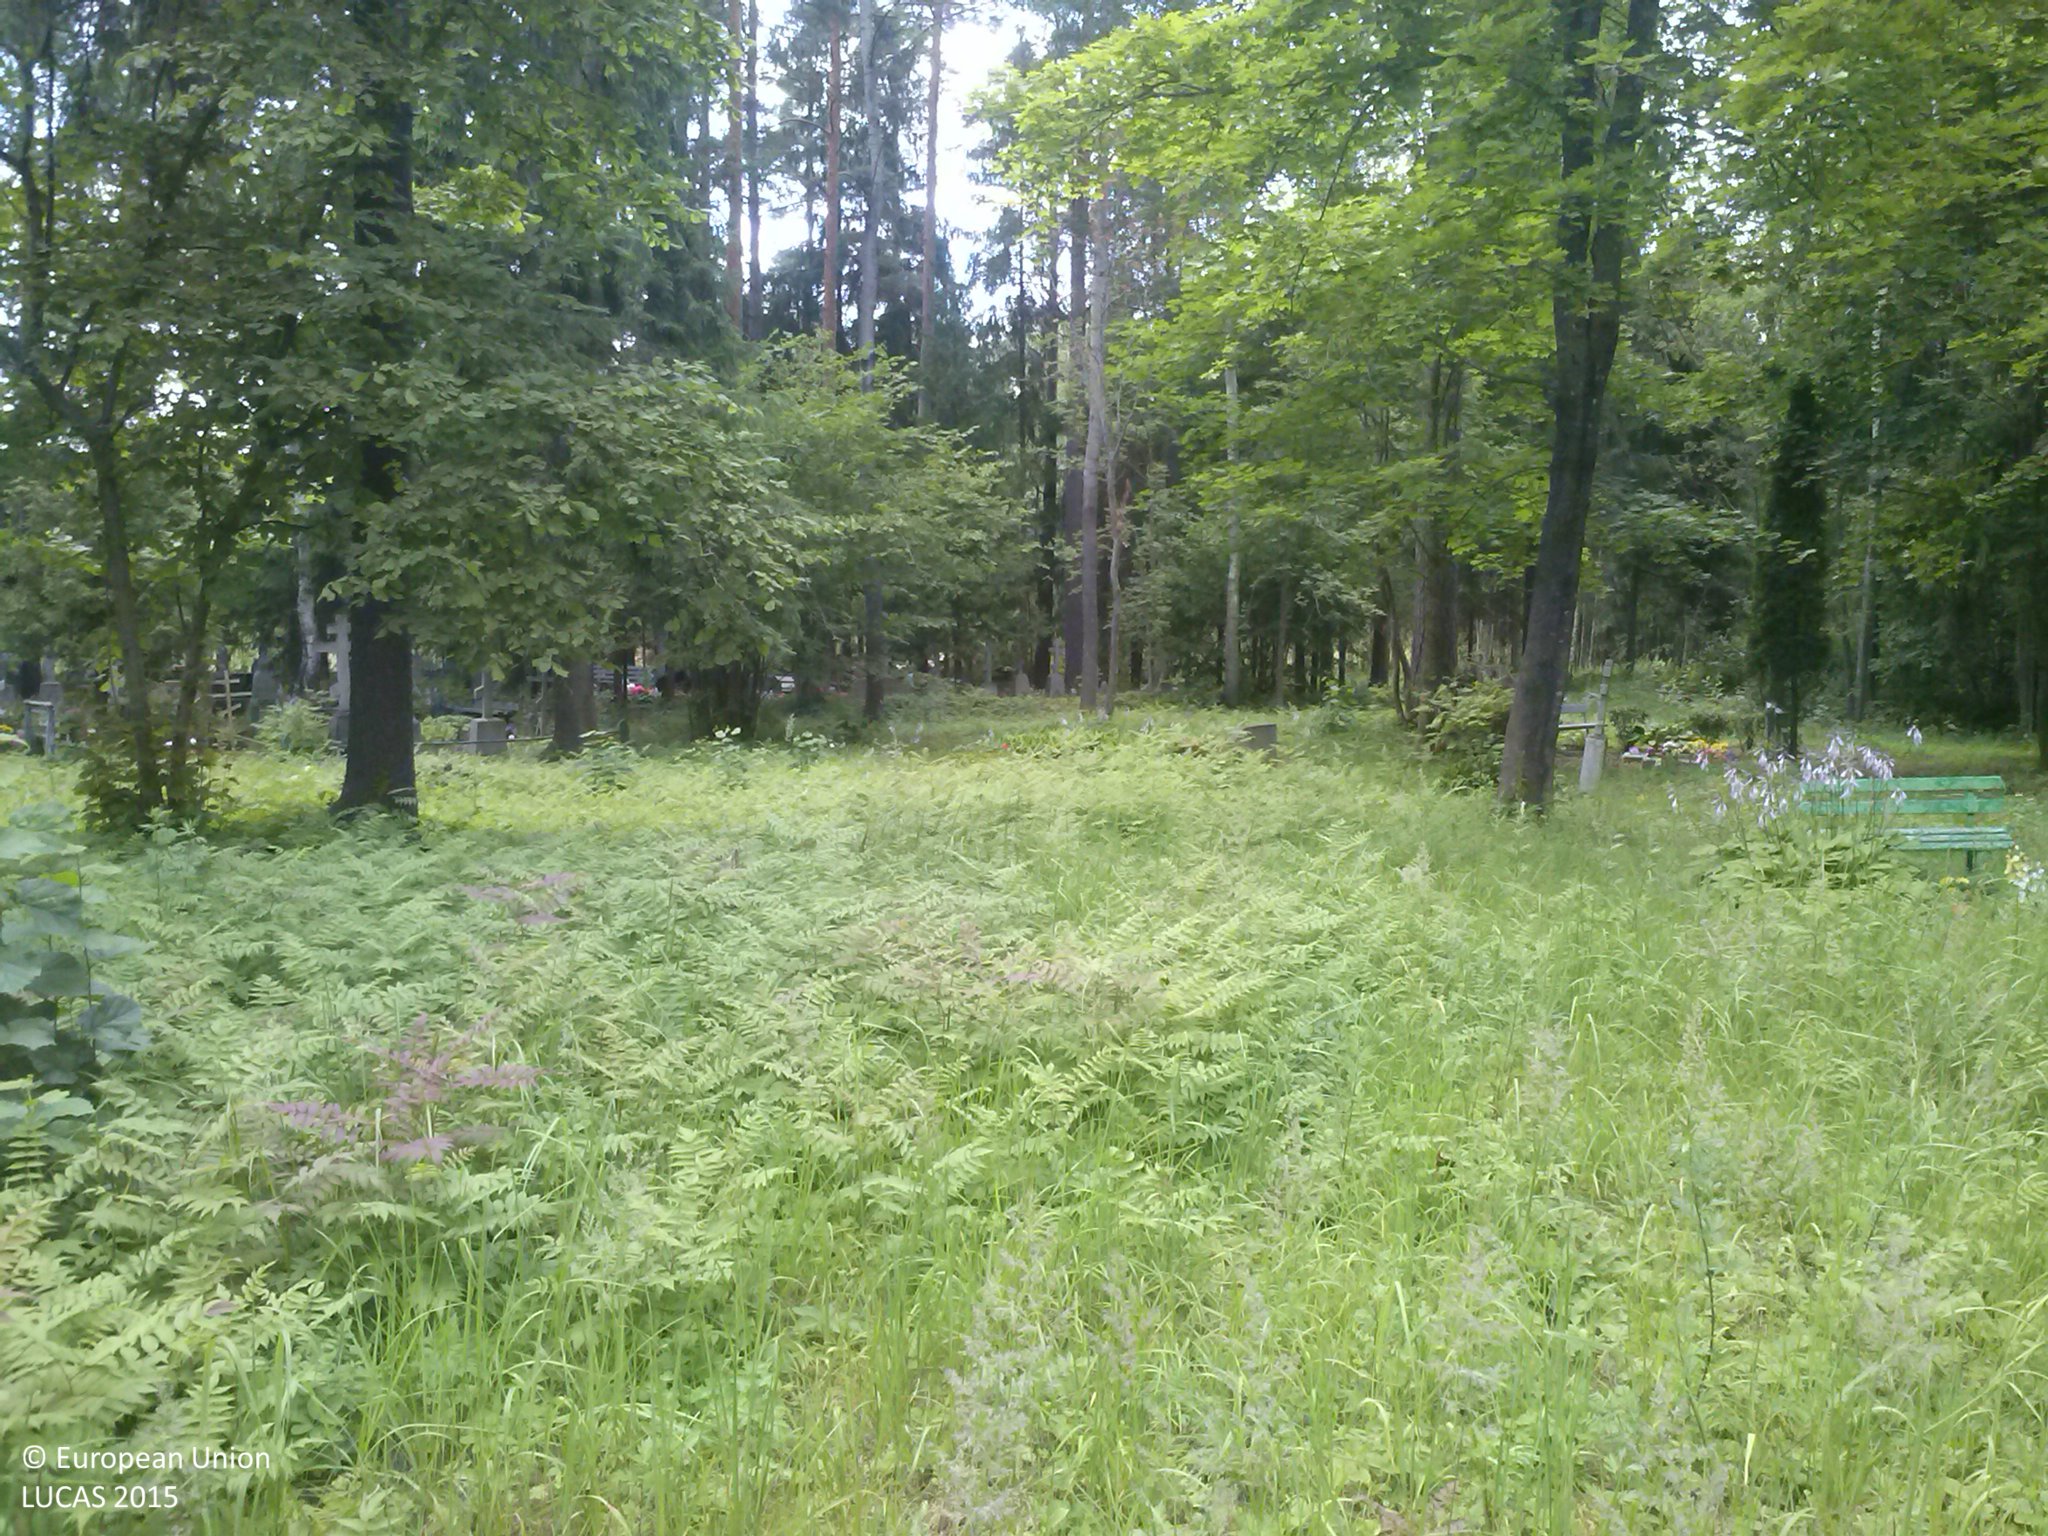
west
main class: Grassland
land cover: Grassland without tree/shrub cover
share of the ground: > 75 %
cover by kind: herbaceous plants 100 %
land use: Community services
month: July
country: LV
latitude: 56.5477
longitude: 27.0314
